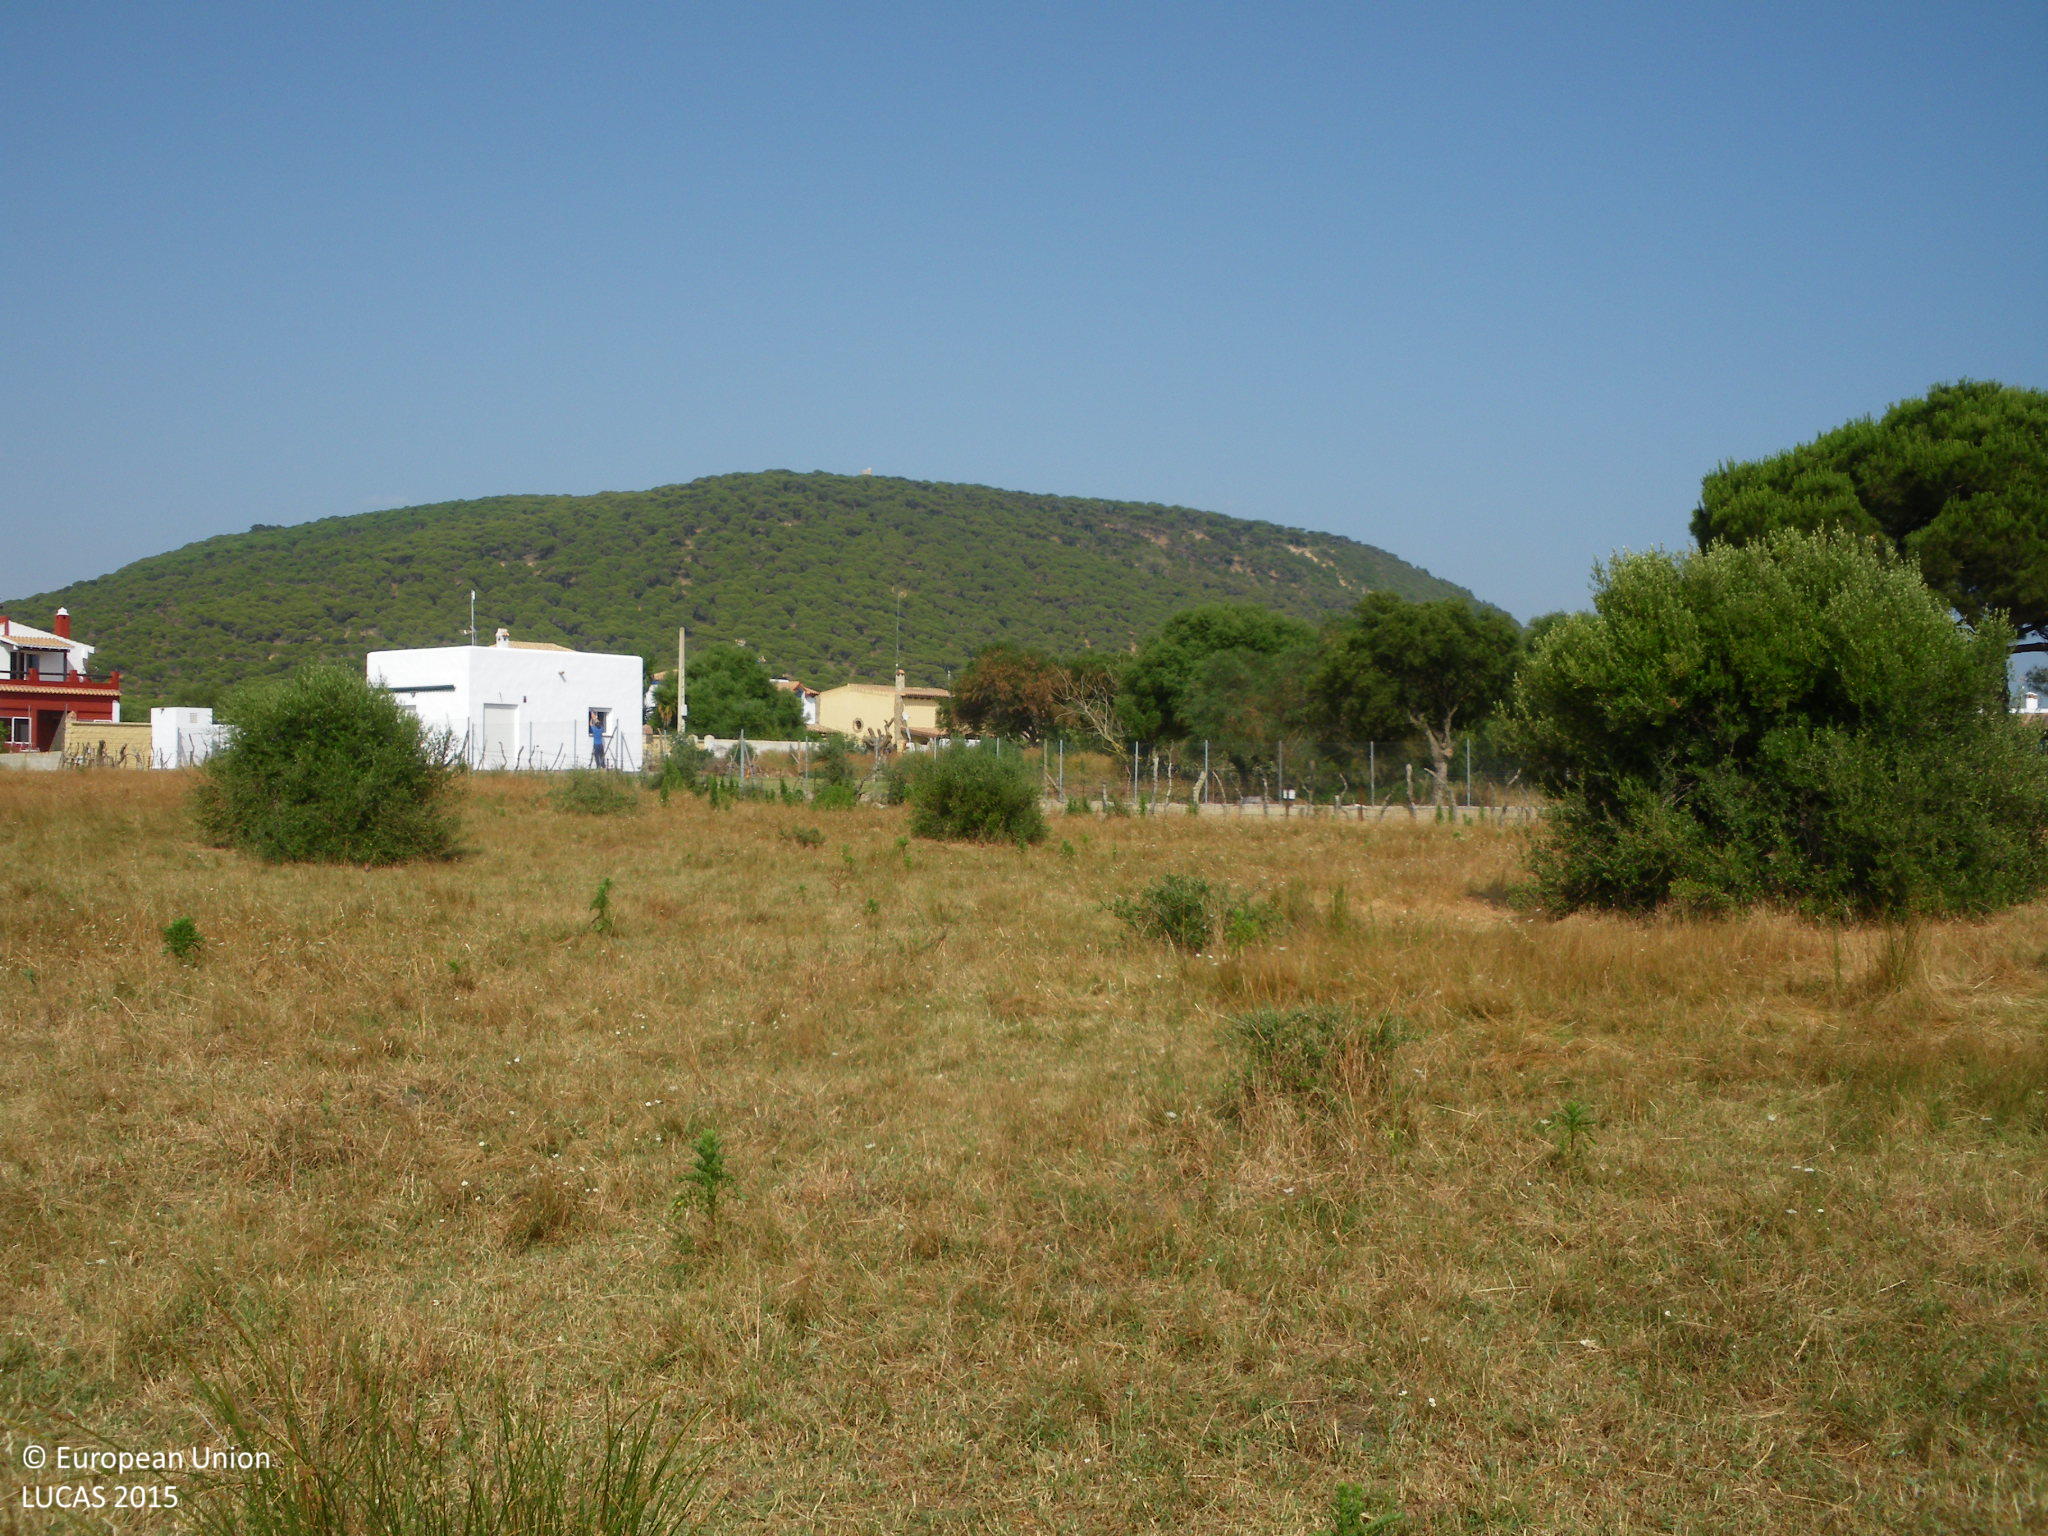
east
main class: Grassland
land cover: Grassland without tree/shrub cover
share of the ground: > 75 %
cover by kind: herbaceous plants 100 %
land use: Agriculture (excluding fallow land and kitchen gardens)
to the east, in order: Grassland without tree/shrub cover; Fences; Artificial constructions in urban areas; Grassland with sparse tree/shrub cover; Grassland without tree/shrub cover
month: June
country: ES
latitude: 36.1943
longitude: -6.0256
